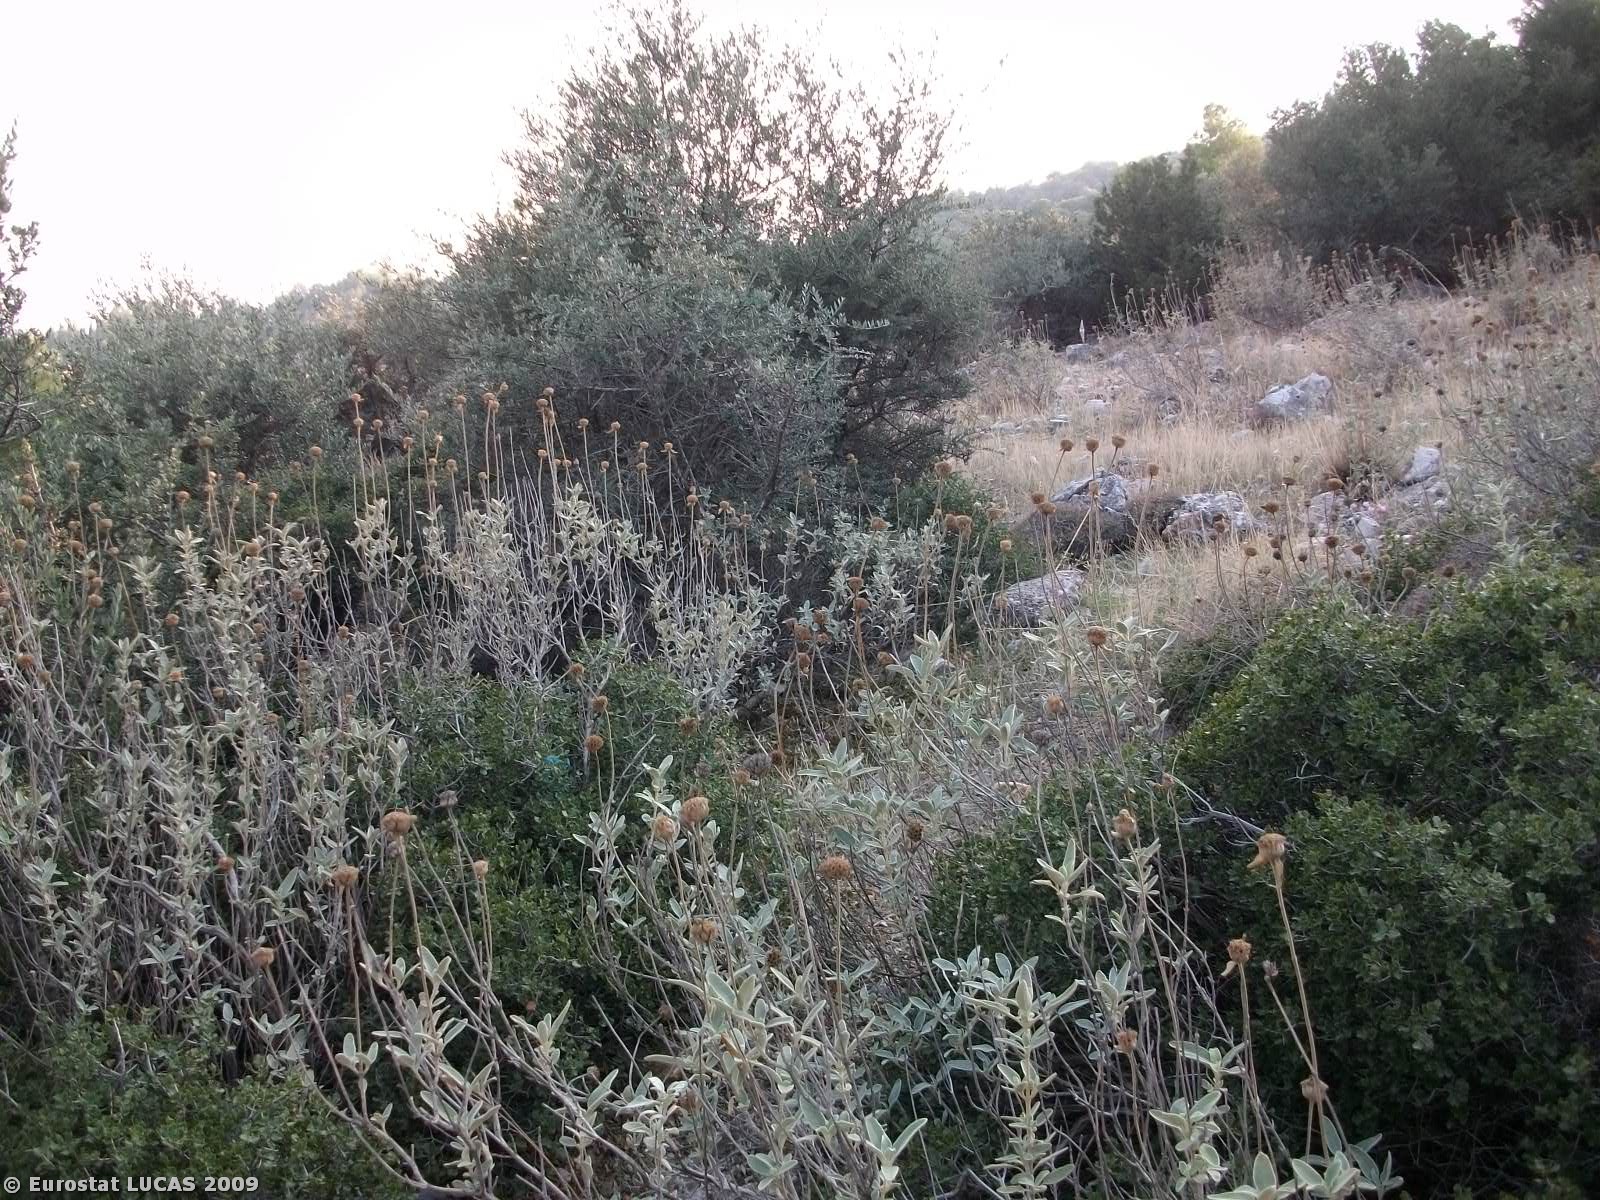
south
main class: Grassland
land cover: Grassland with sparse tree/shrub cover
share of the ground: > 75 %
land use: Unused
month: October
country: GR
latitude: 38.0556
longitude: 23.6913
